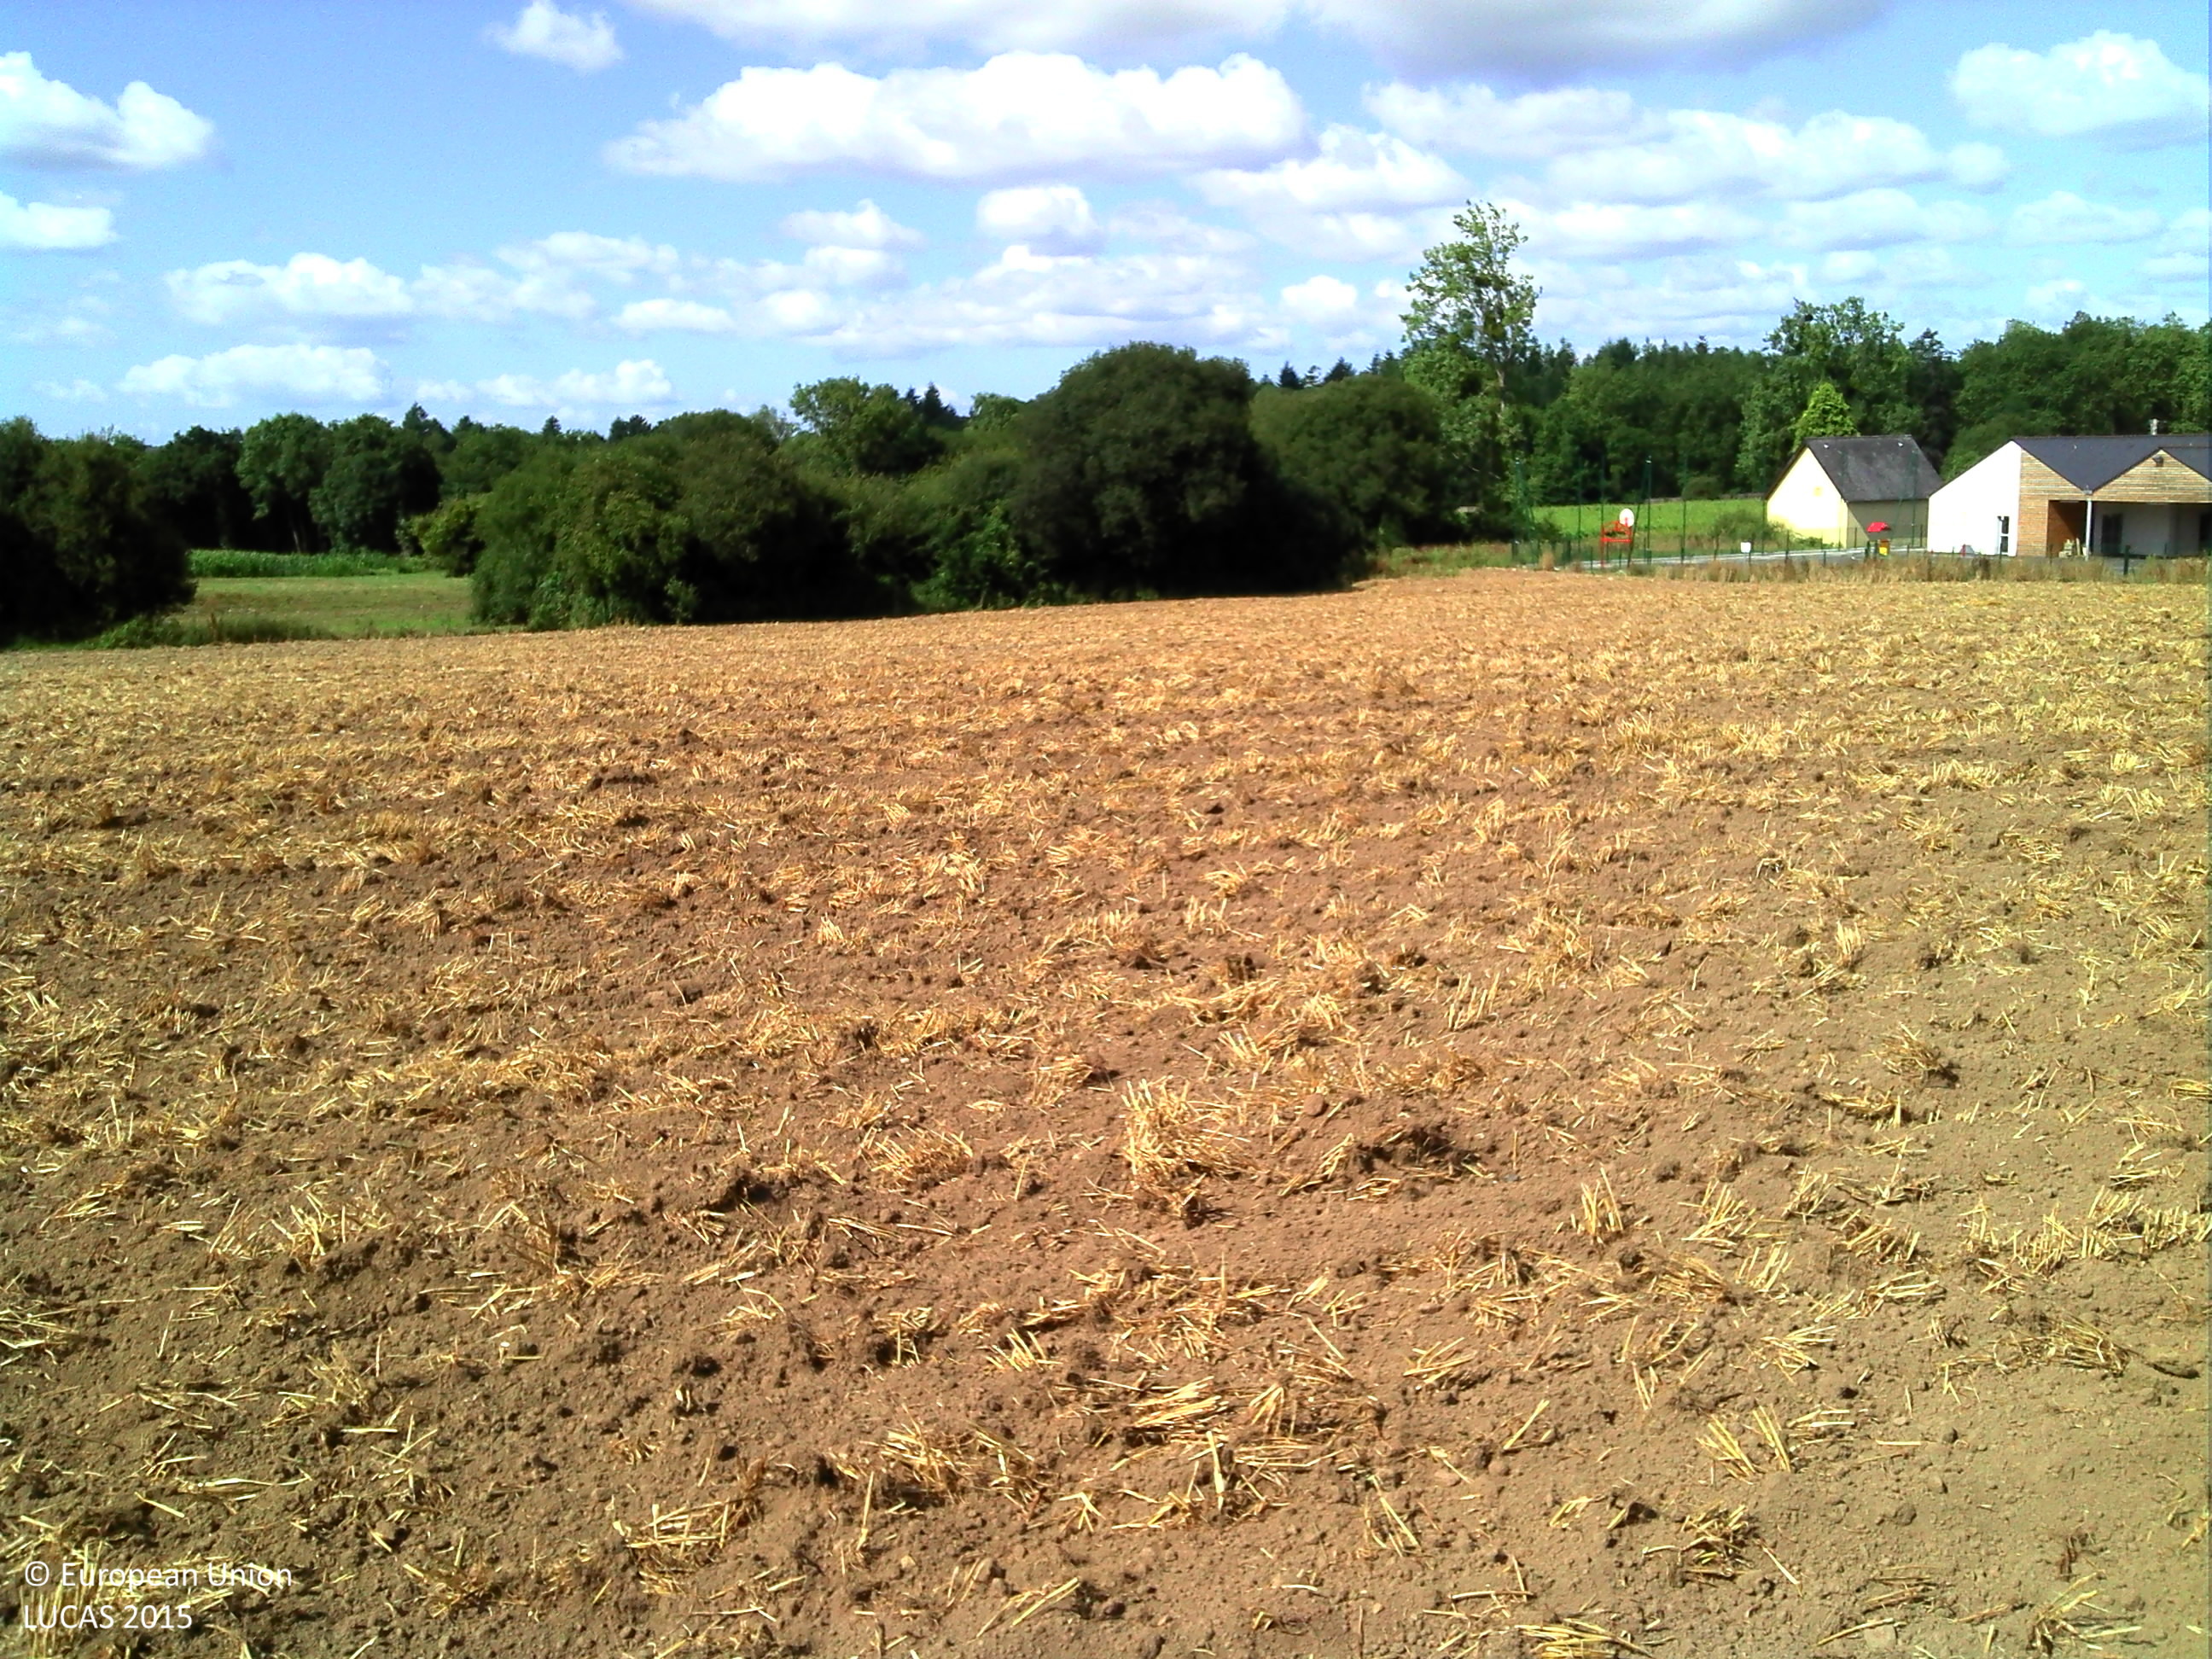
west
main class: Cropland
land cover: Barley
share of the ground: > 75 %
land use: Agriculture (excluding fallow land and kitchen gardens)
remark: Tilled/Sowed
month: July
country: FR
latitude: 47.7911
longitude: -3.1920
